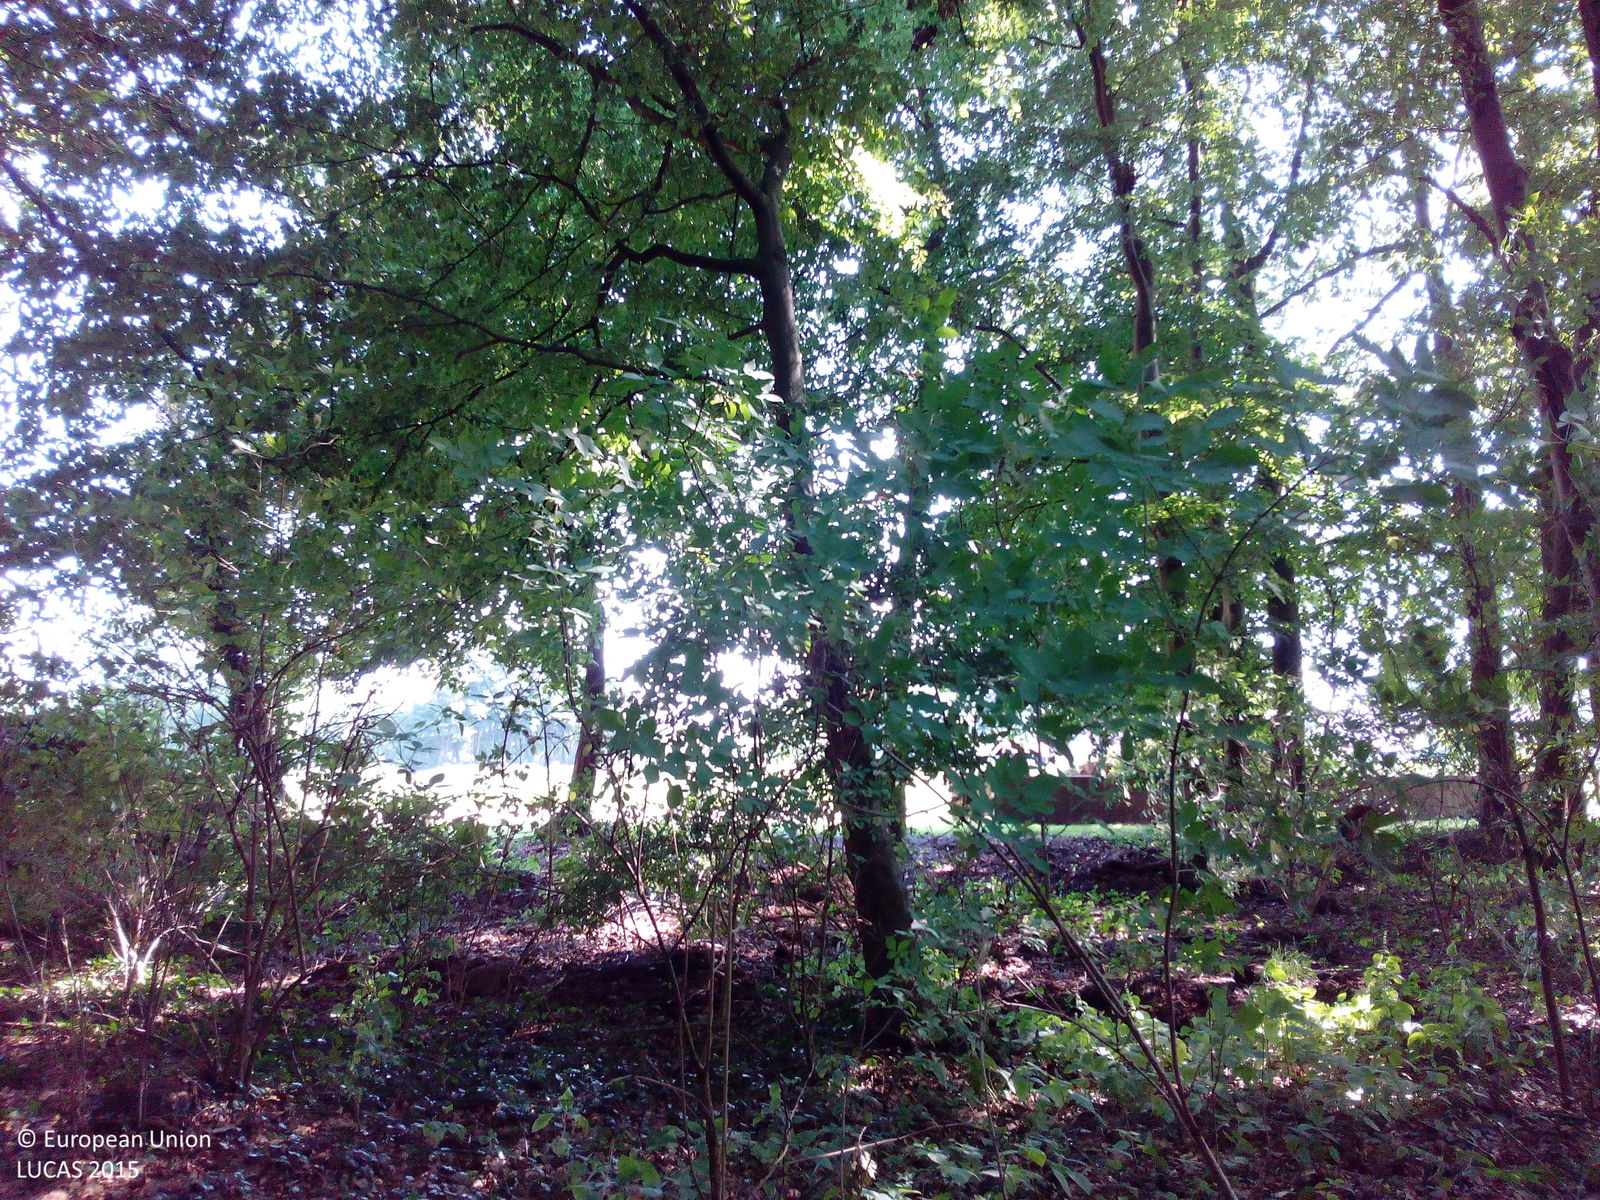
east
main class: Woodland
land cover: Broadleaved woodland
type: mesophytic deciduous forest
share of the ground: > 75 %
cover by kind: broadleaved forest trees 90 %, shrubs 5 %, herbaceous plants 5 %
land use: Forestry
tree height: > 5 m
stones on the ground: < 10 %
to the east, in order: Broadleaved woodland; Artificial constructions in urban areas; Grassland without tree/shrub cover; Ditches and canals; Grass margins; Maize; Lines of trees; Ditches and canals; Artificial constructions in urban areas; Common wheat
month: August
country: DE
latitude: 52.6474
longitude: 7.9460
